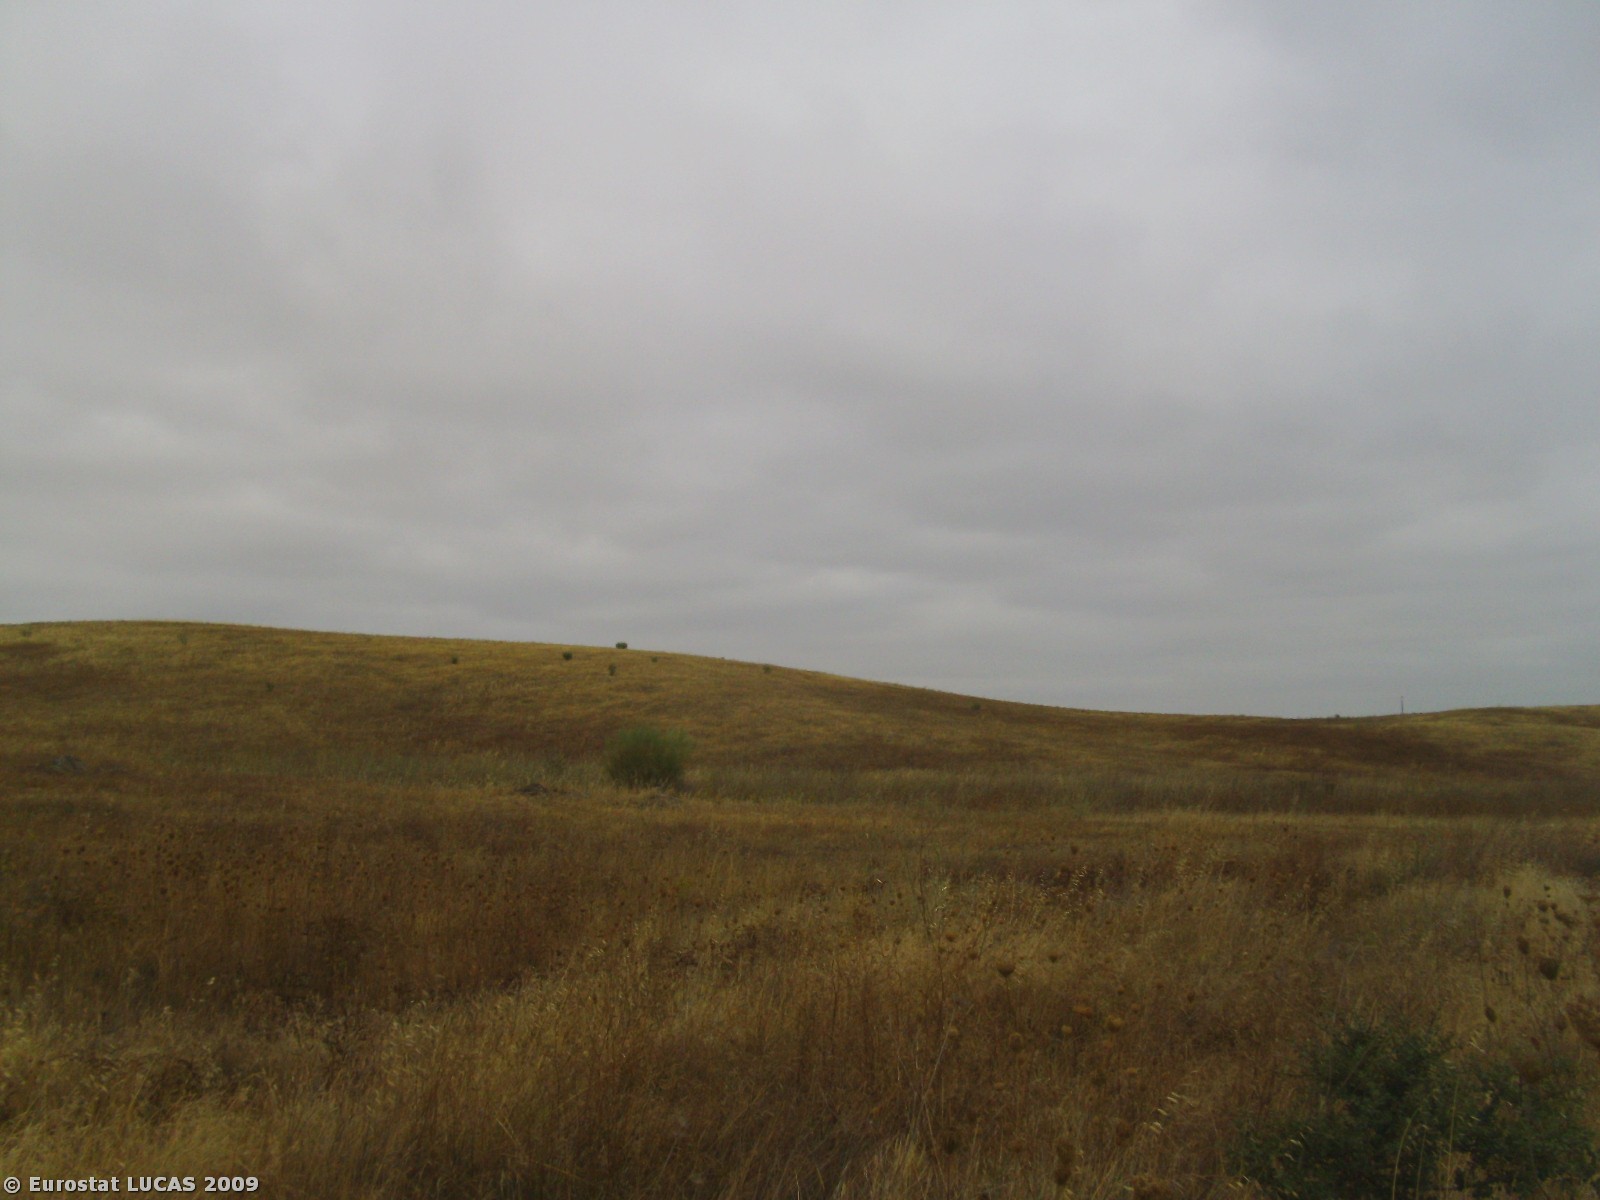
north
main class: Grassland
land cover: Spontaneously vegetated surfaces
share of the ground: > 75 %
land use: Fallow land
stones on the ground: < 10 %
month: August
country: PT
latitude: 38.4426
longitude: -7.6875
